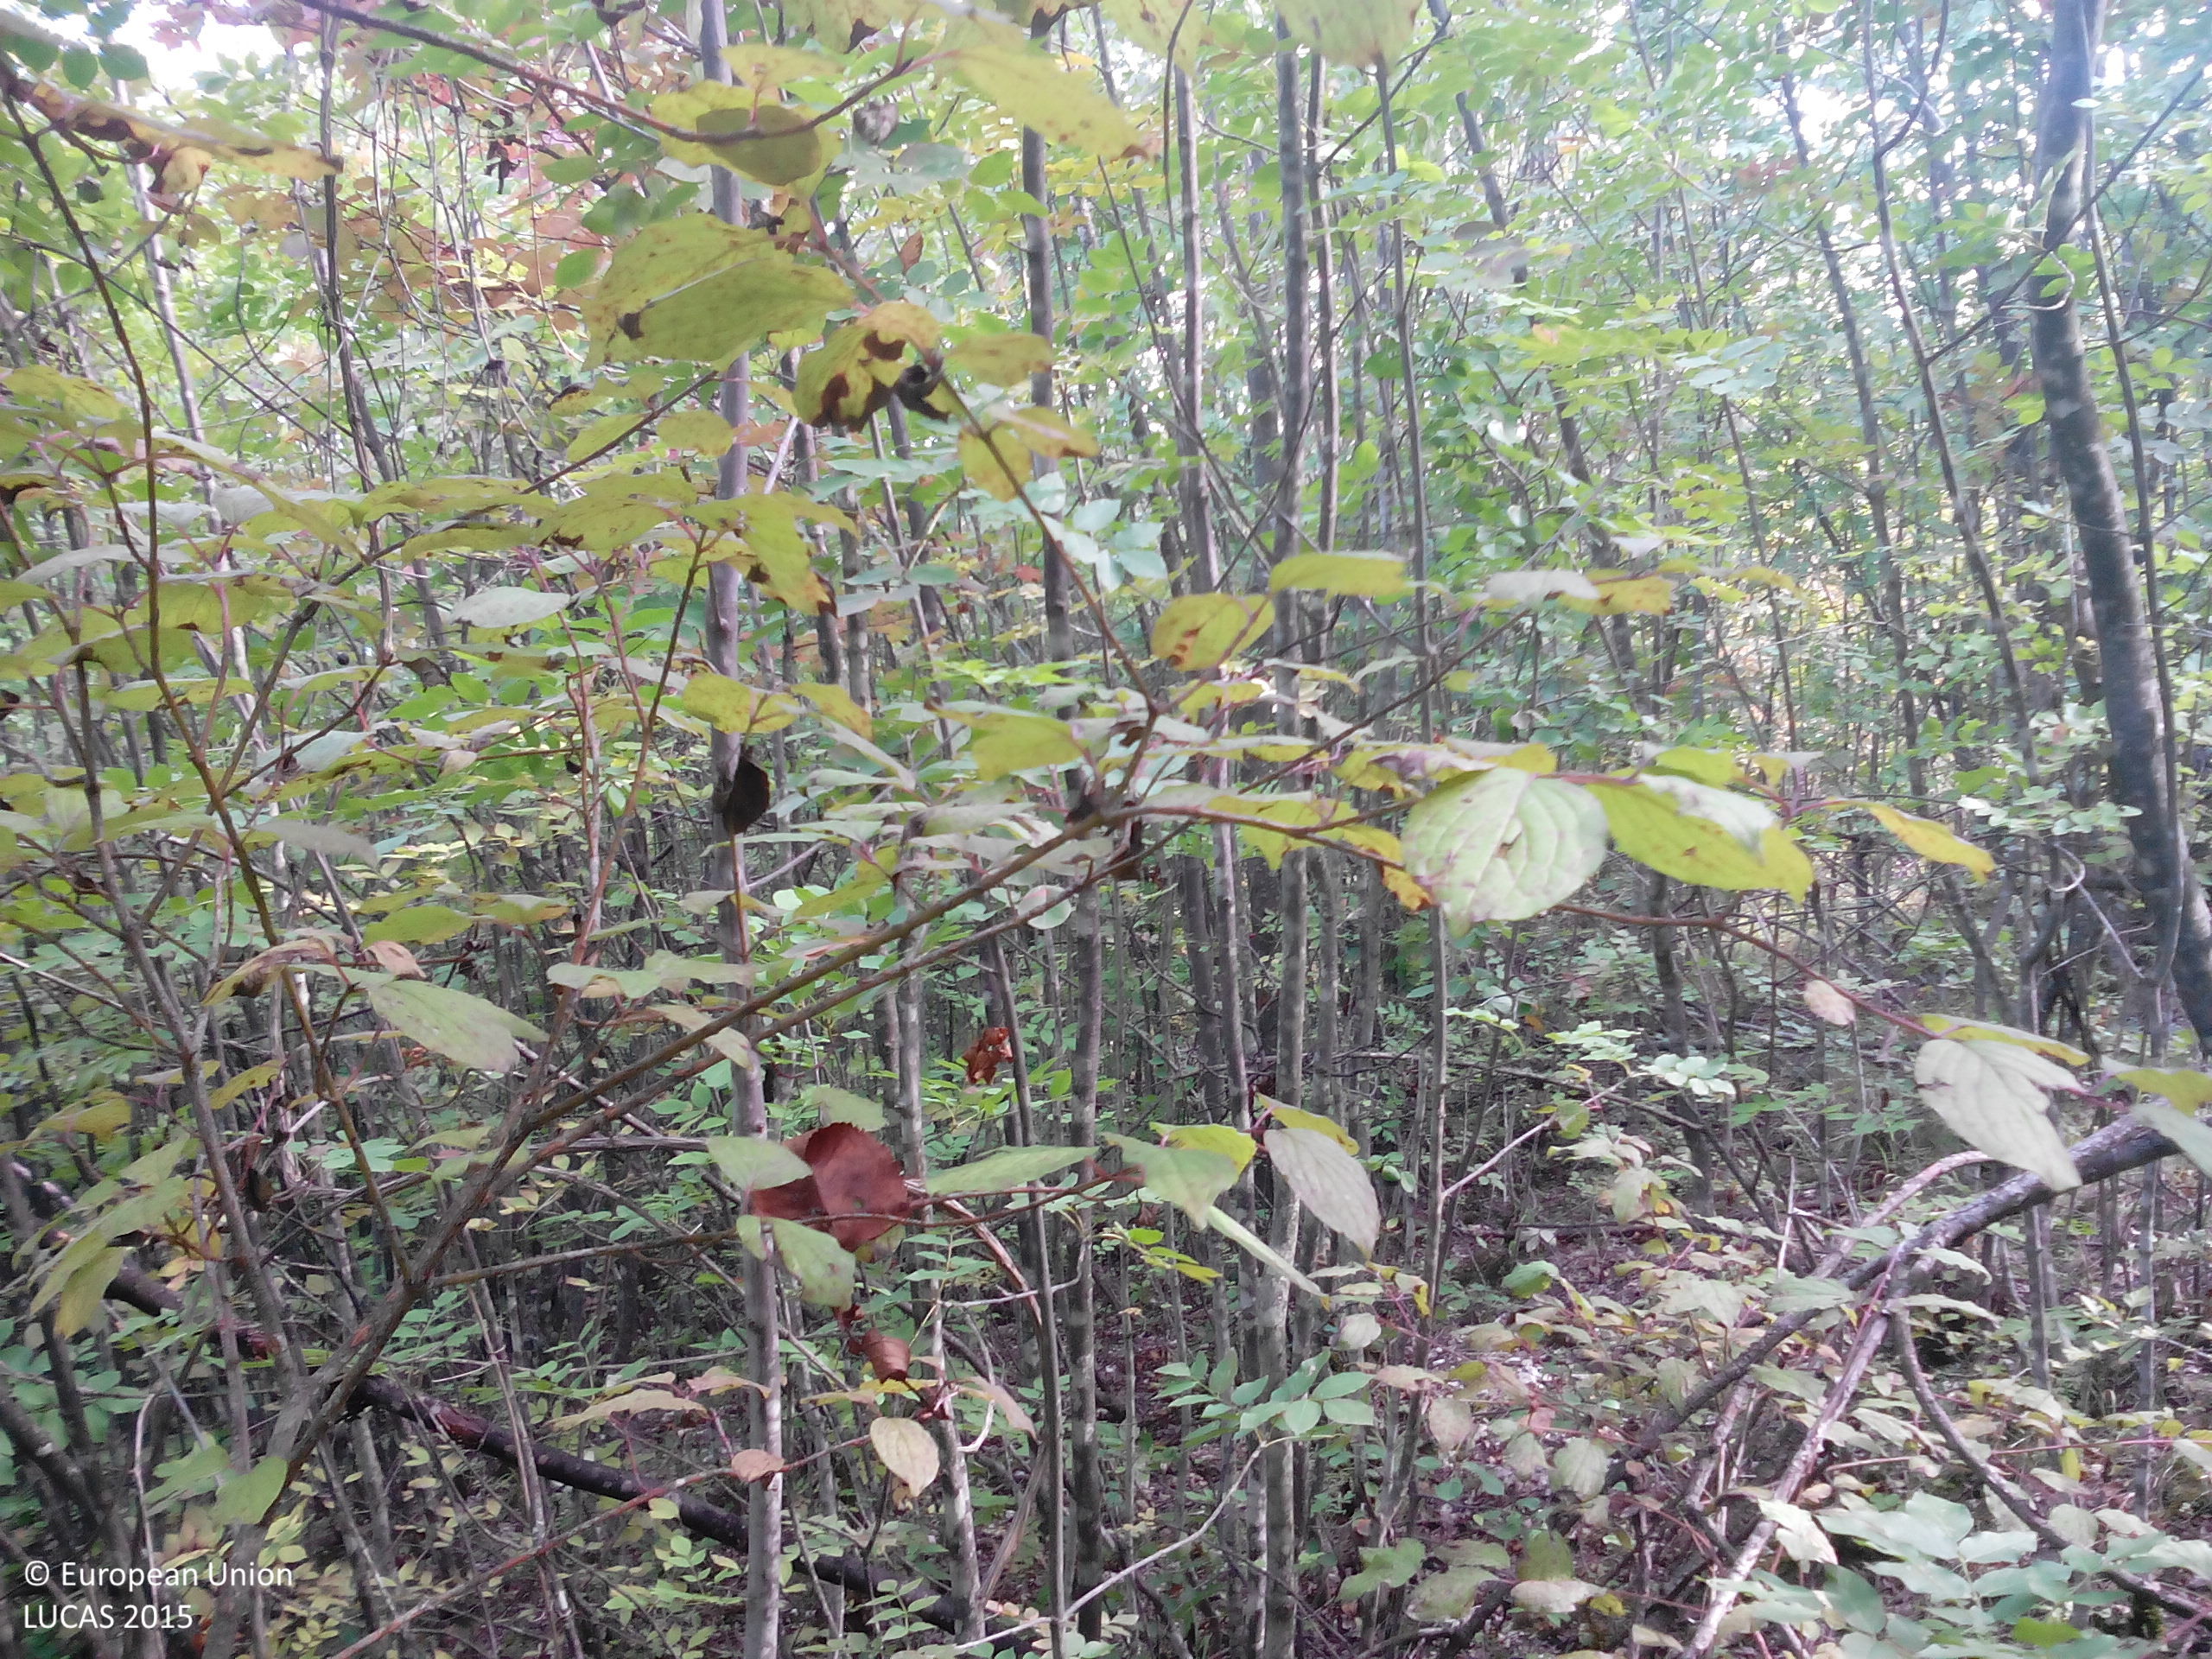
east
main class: Woodland
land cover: Broadleaved woodland
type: beech forest
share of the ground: > 75 %
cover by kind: broadleaved forest trees 100 %
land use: Forestry
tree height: > 5 m
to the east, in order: Broadleaved woodland
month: October
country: BG
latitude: 43.2324
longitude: 23.7257
